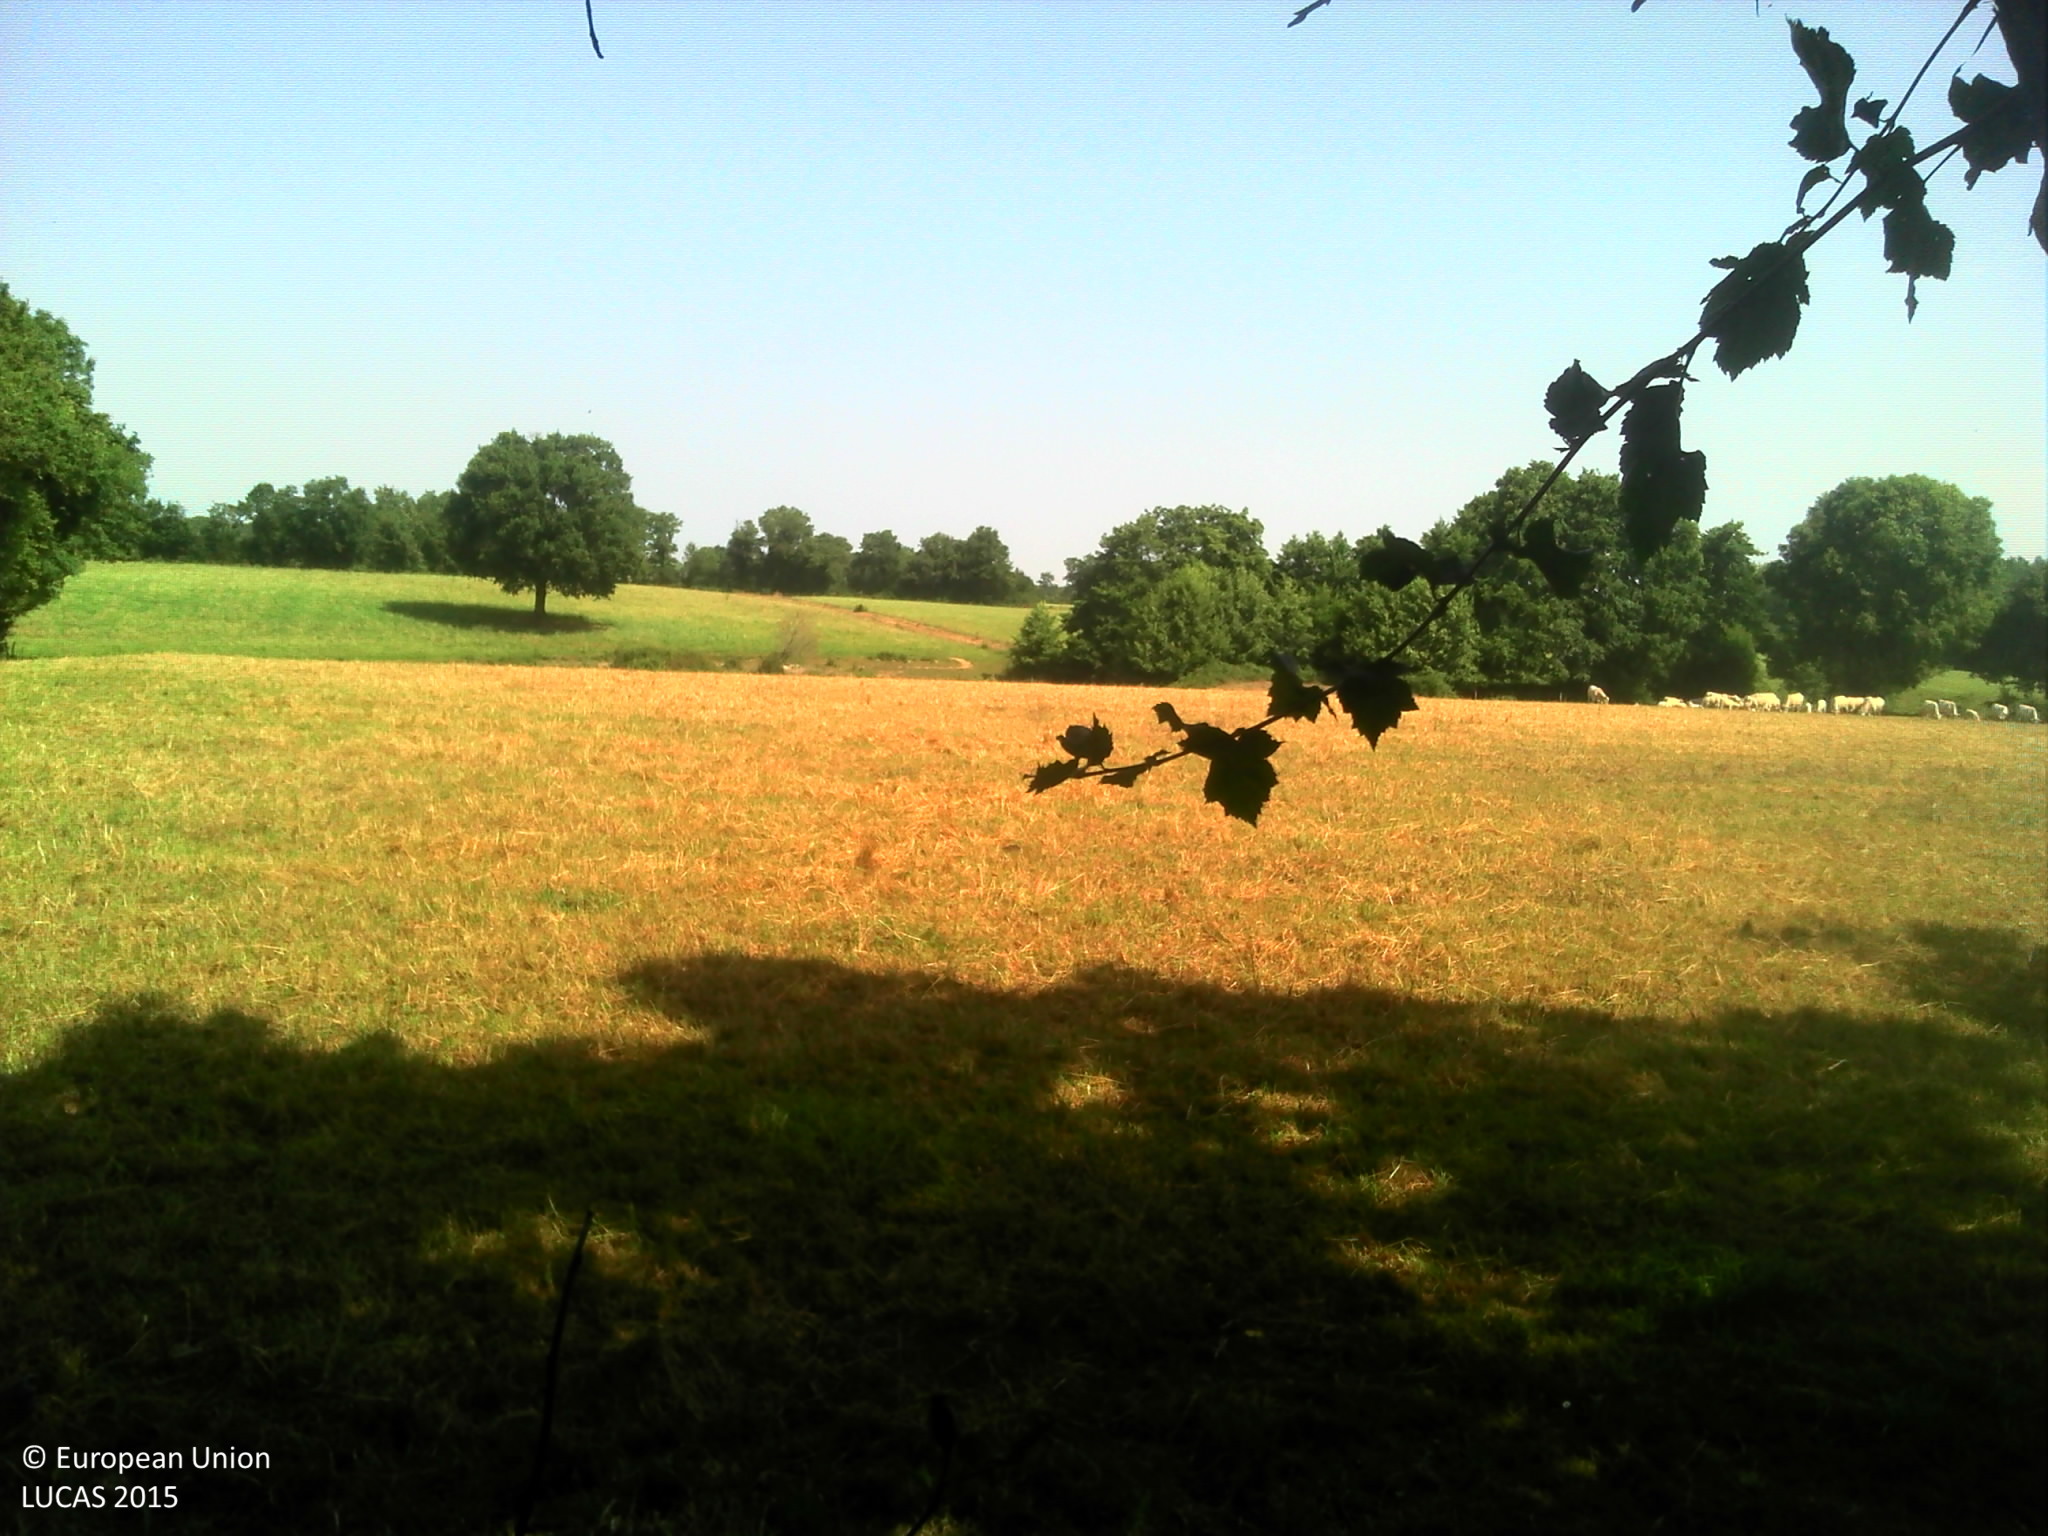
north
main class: Cropland
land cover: Temporary grasslands
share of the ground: > 75 %
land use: Agriculture (excluding fallow land and kitchen gardens)
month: July
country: FR
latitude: 46.5740
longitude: -1.5867
